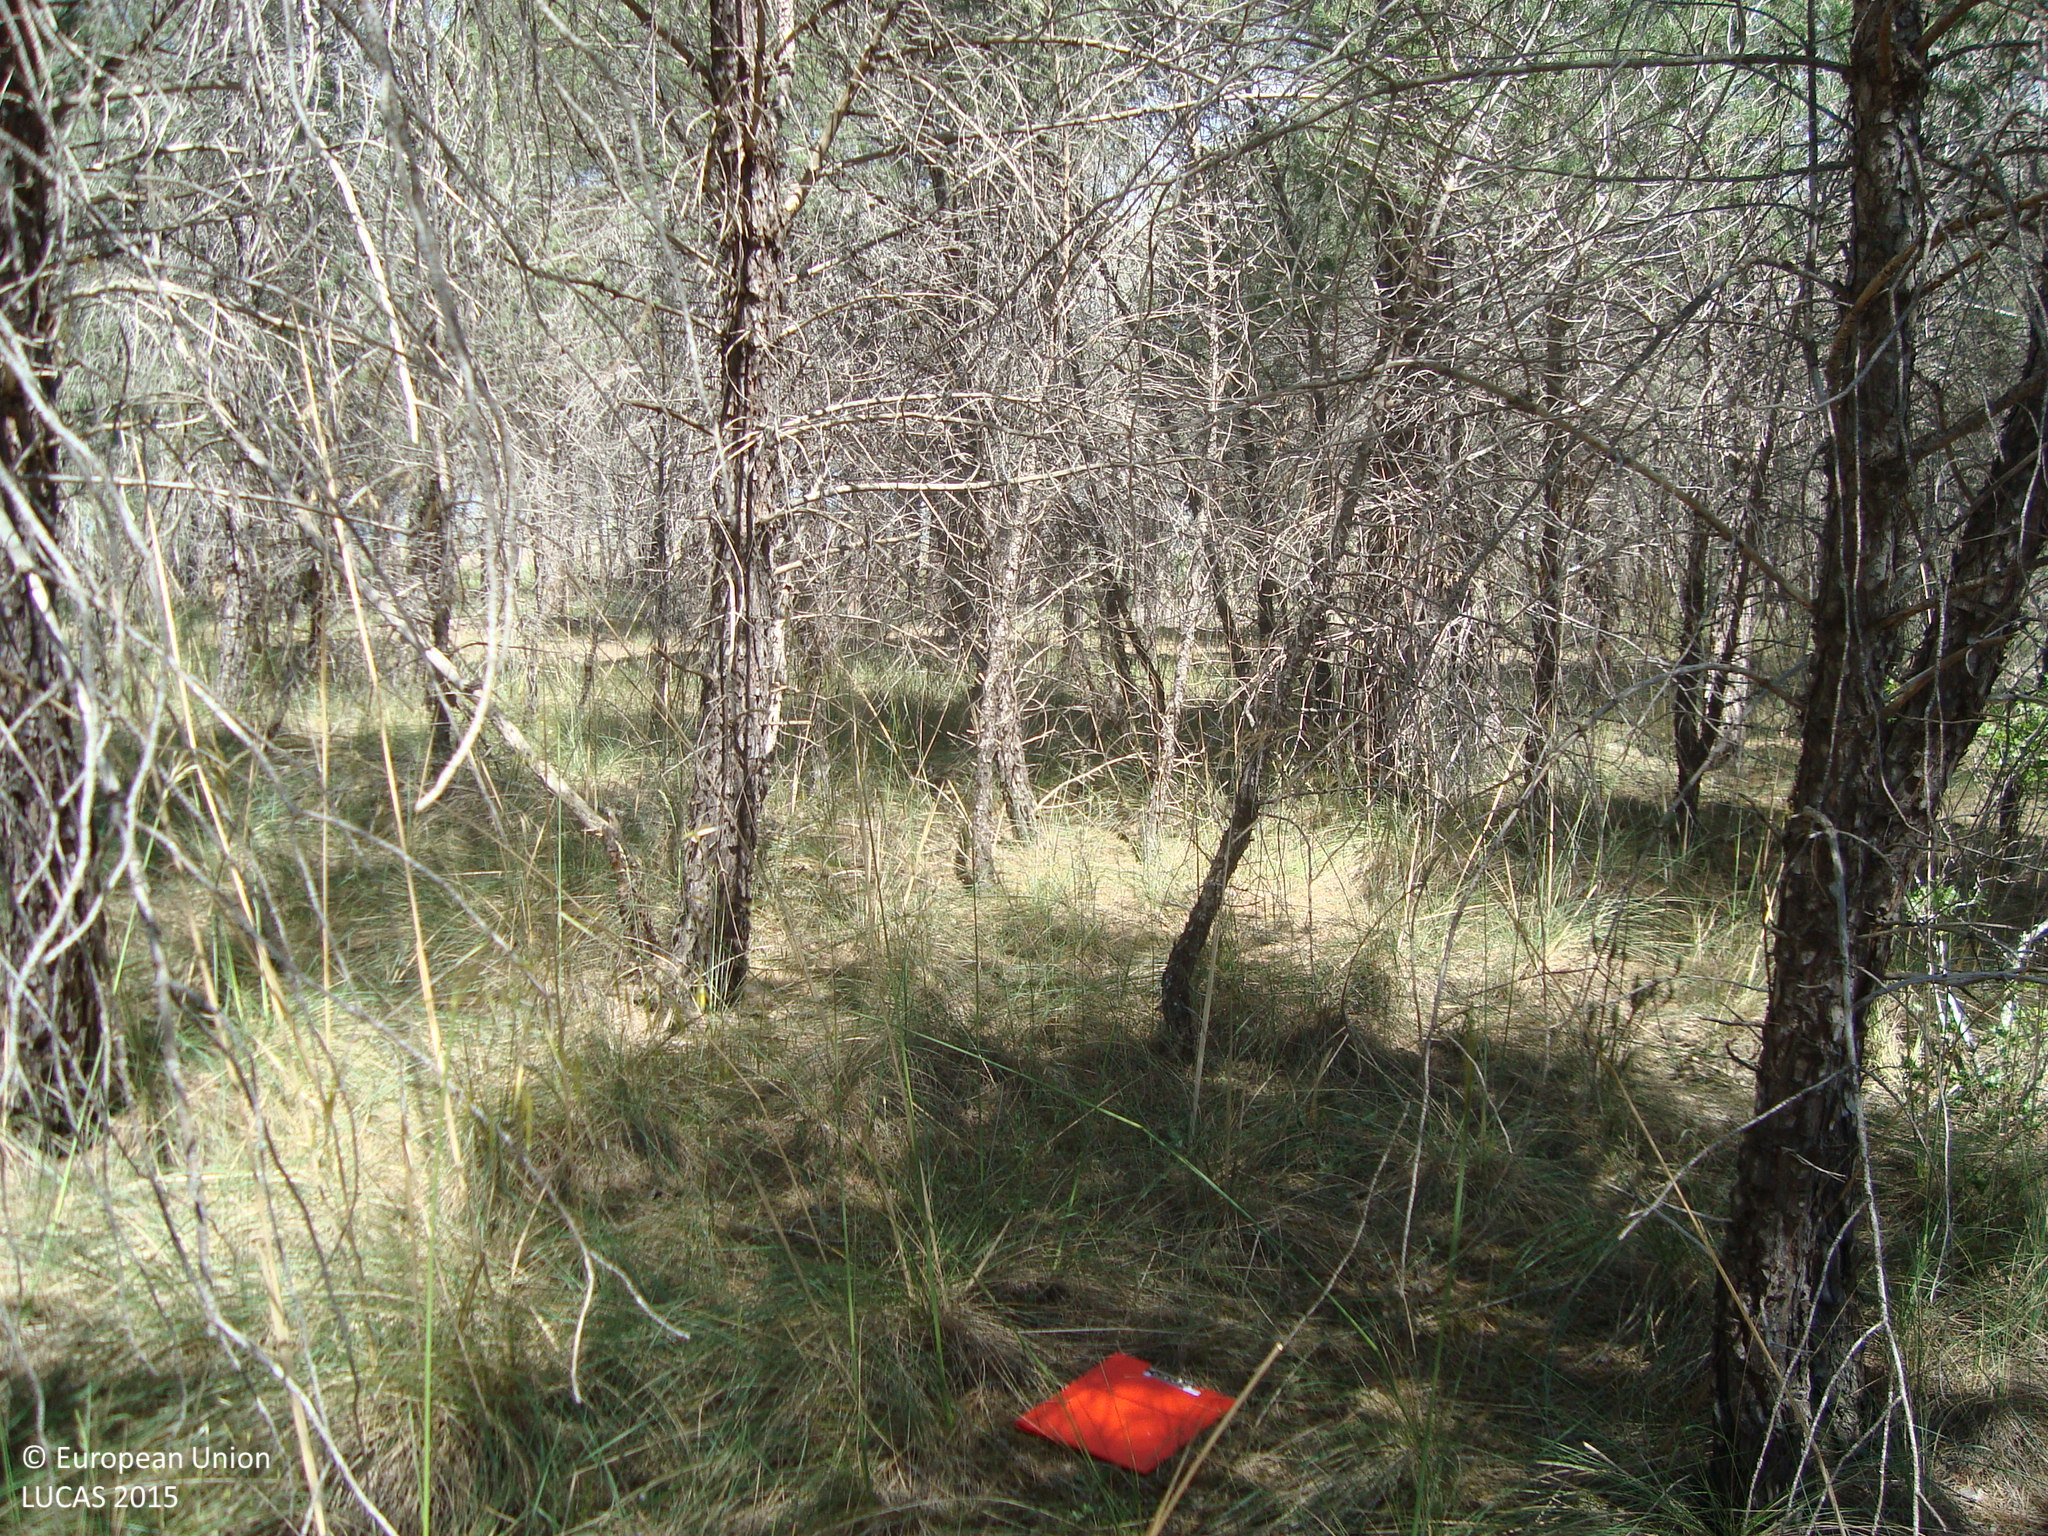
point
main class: Woodland
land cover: Pine dominated mixed woodland
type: coniferous forest of the mediterranean region
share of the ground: > 75 %
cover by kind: coniferous forest trees 55 %, broadleaved forest trees 25 %, shrubs 10 %, herbaceous plants 10 %
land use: Semi-natural and natural areas not in use
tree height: > 5 m
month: May
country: ES
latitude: 41.6345
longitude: -4.1647
